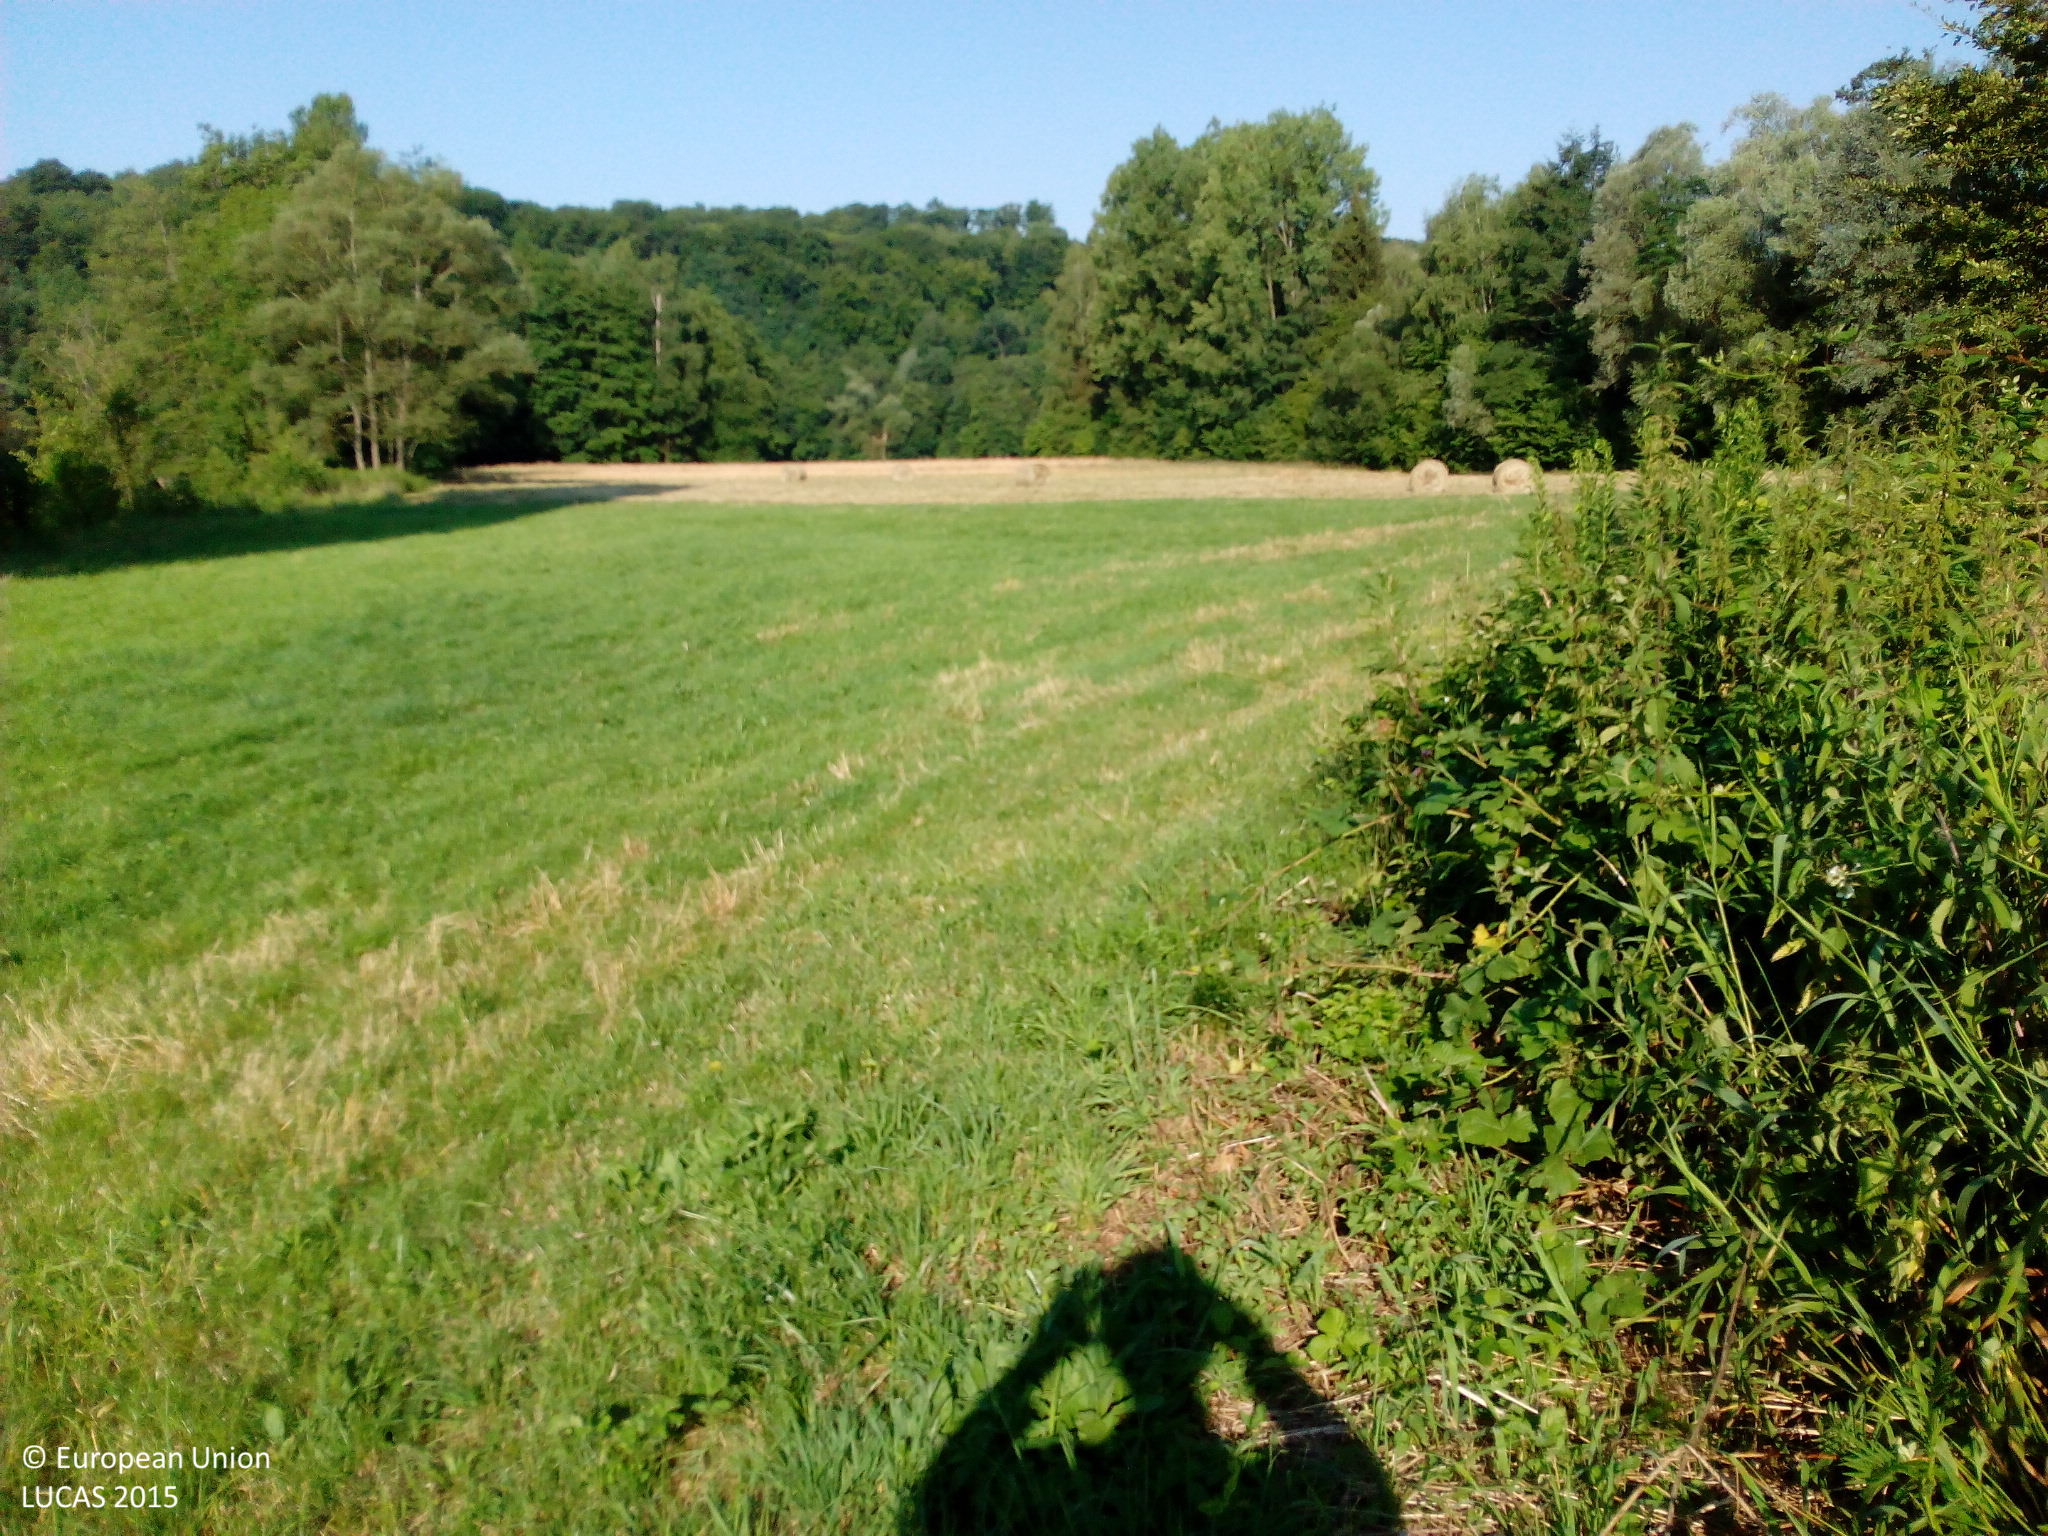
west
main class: Grassland
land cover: Grassland without tree/shrub cover
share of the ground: > 75 %
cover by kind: herbaceous plants 100 %
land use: Agriculture (excluding fallow land and kitchen gardens)
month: July
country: DE
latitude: 49.1398
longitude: 7.1082
